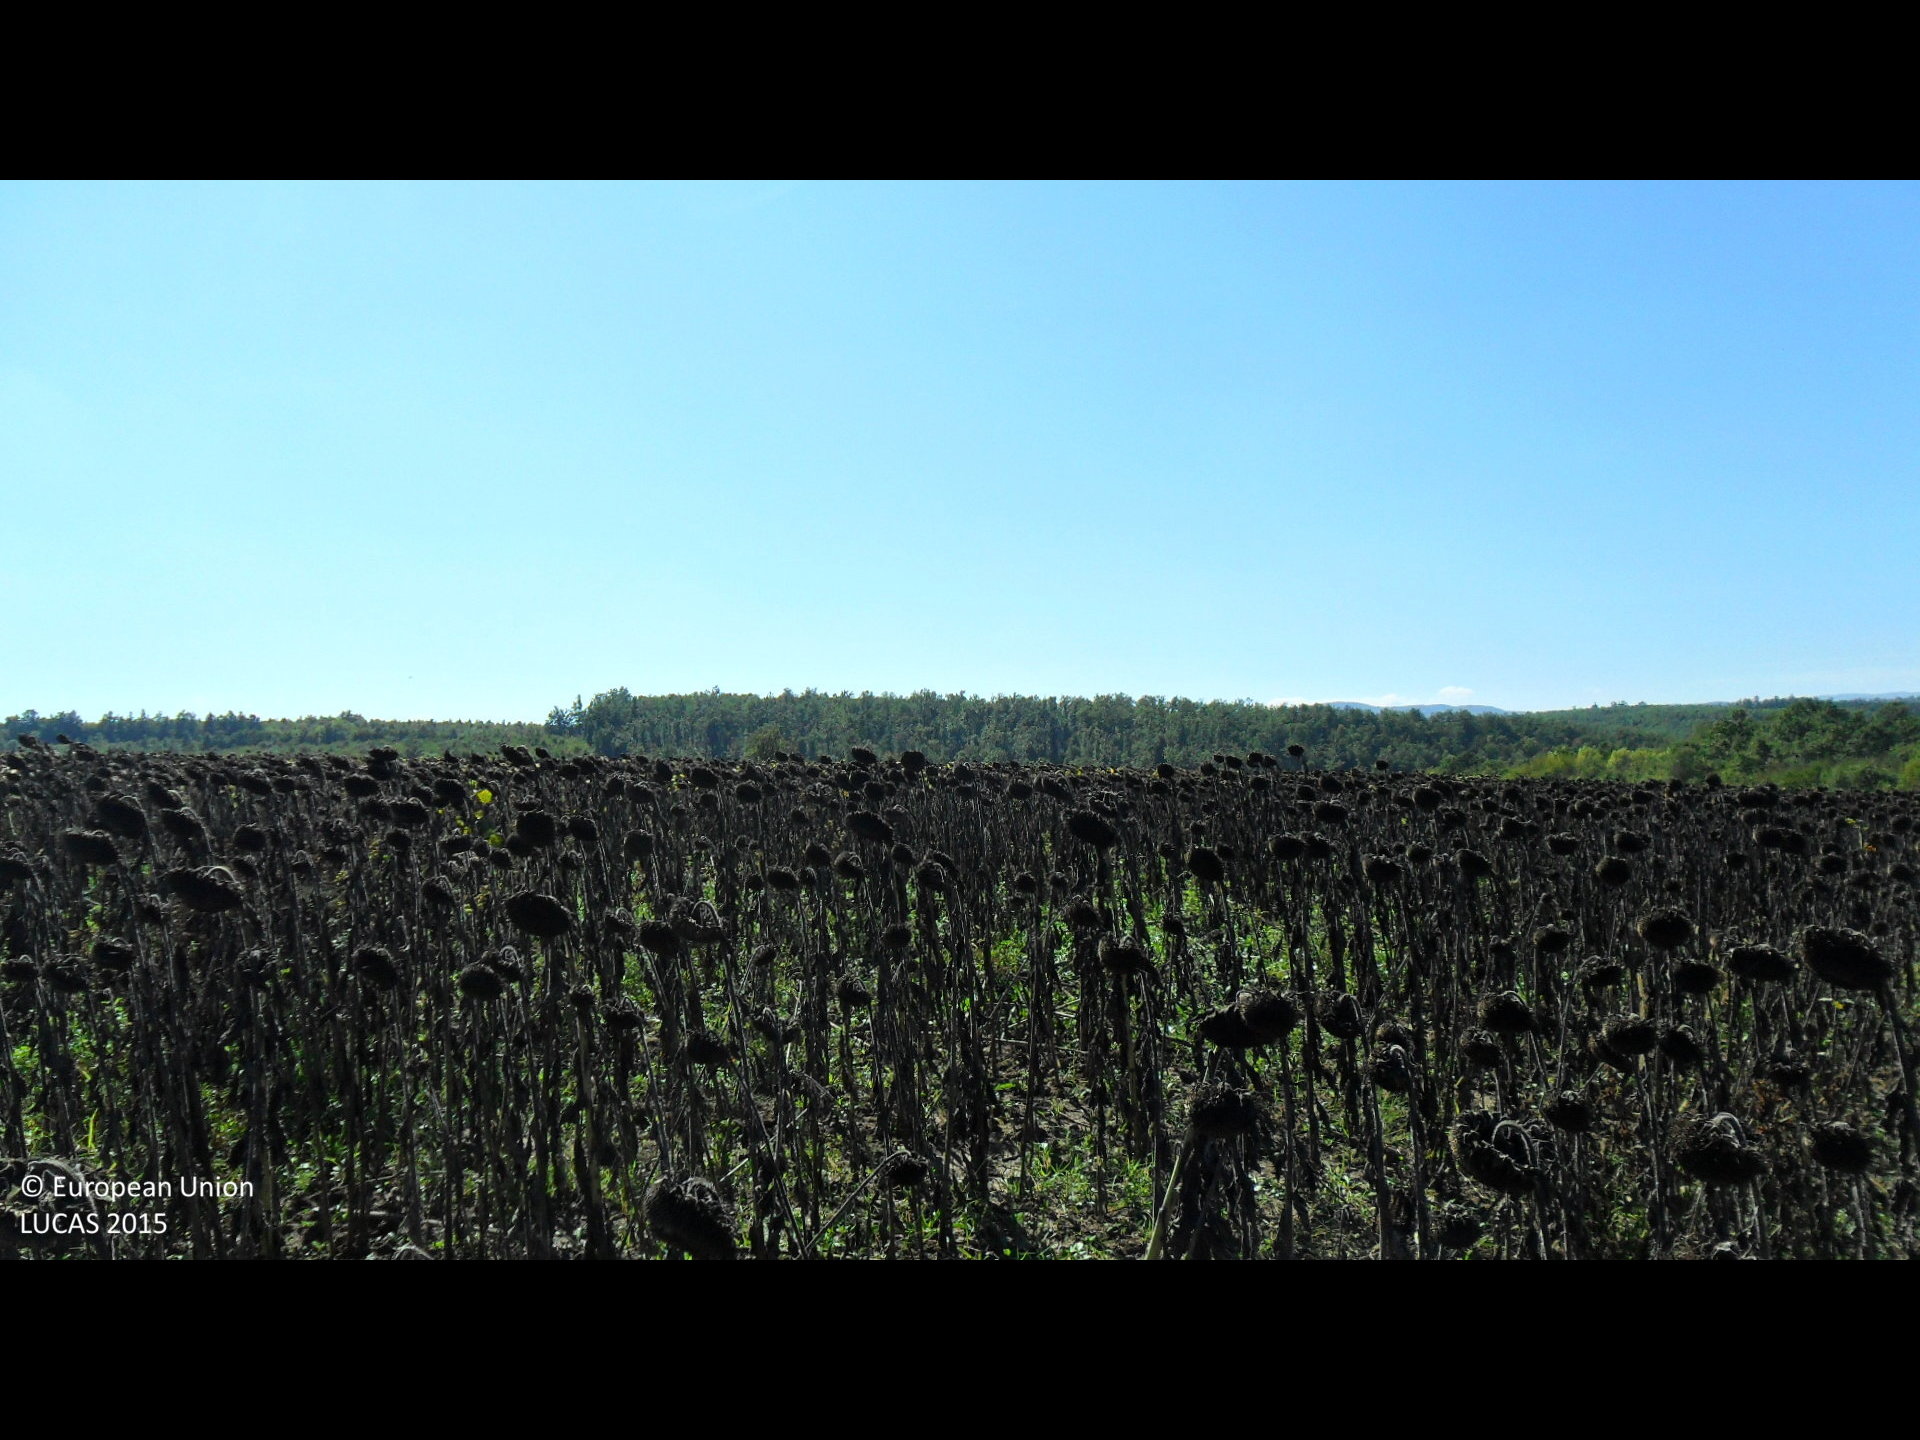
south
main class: Cropland
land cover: Sunflower
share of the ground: > 75 %
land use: Agriculture (excluding fallow land and kitchen gardens)
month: October
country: BG
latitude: 43.1351
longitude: 26.2356
